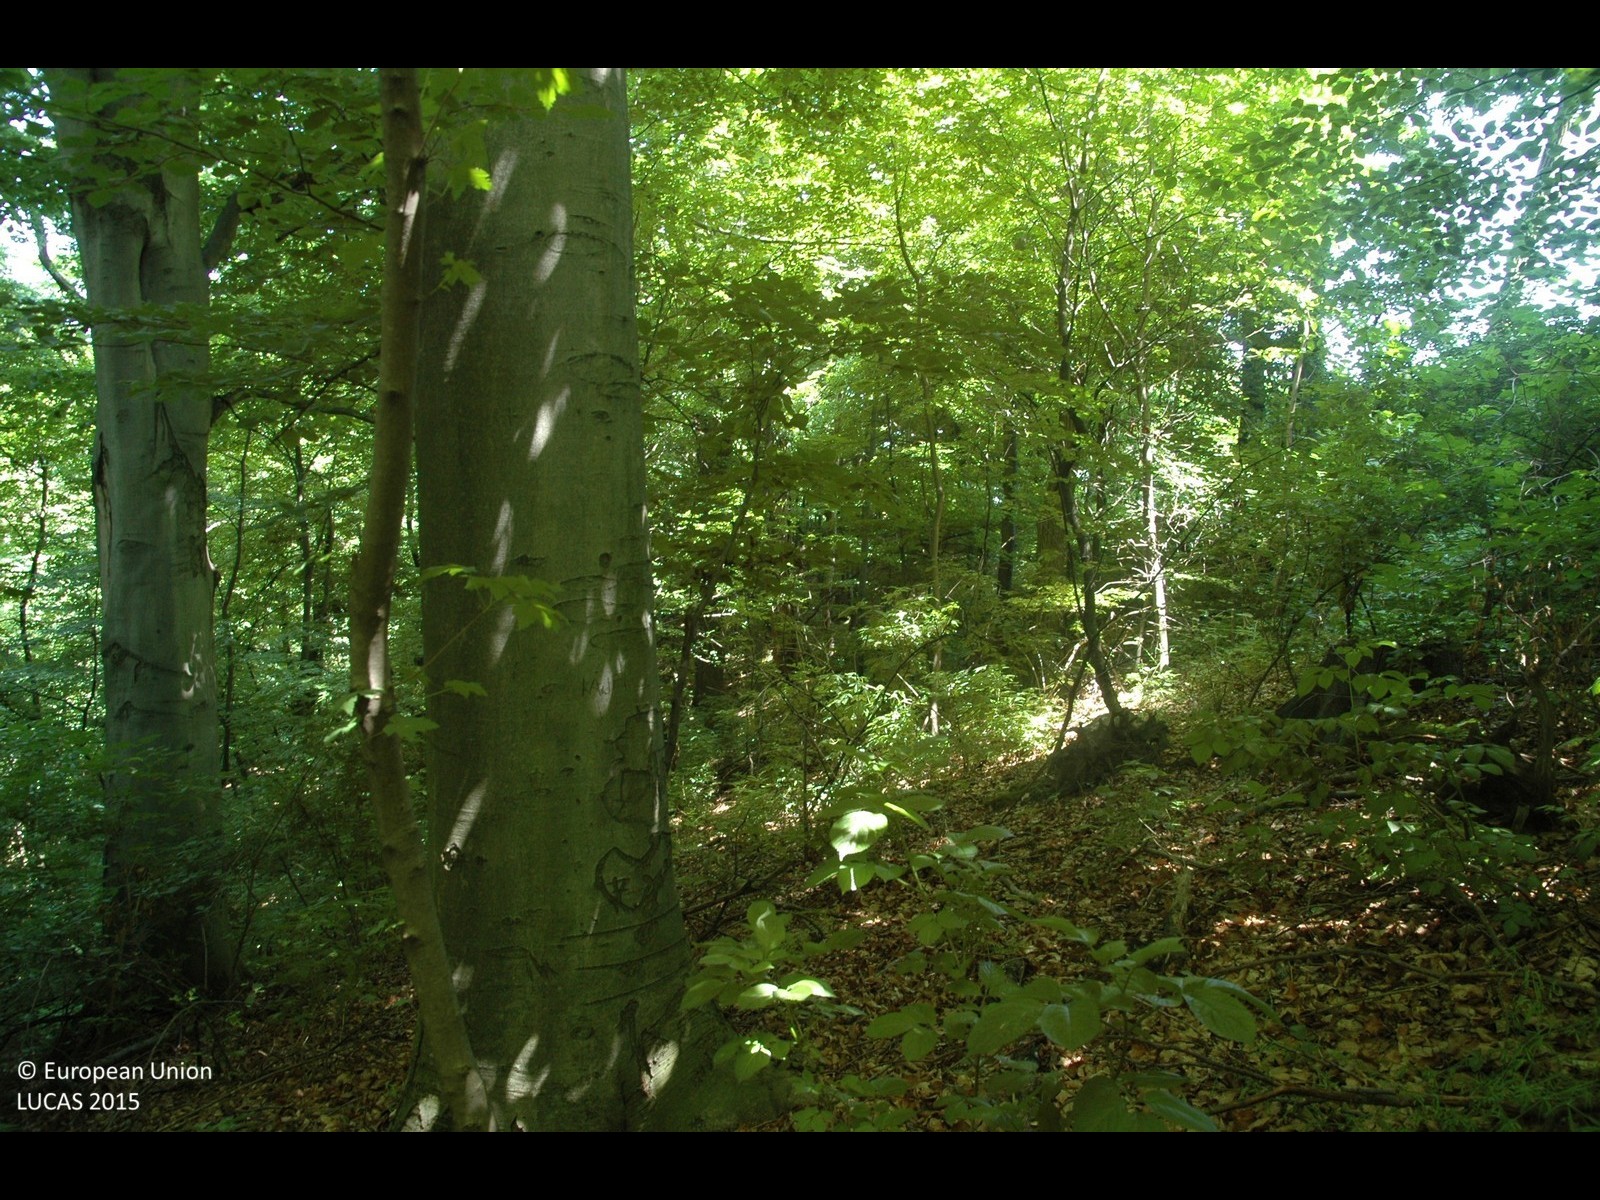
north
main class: Woodland
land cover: Broadleaved woodland
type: beech forest
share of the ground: > 75 %
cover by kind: broadleaved forest trees 90 %, shrubs 5 %, herbaceous plants 5 %
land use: Forestry
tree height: > 5 m
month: May
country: HR
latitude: 46.5043
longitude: 16.3731
